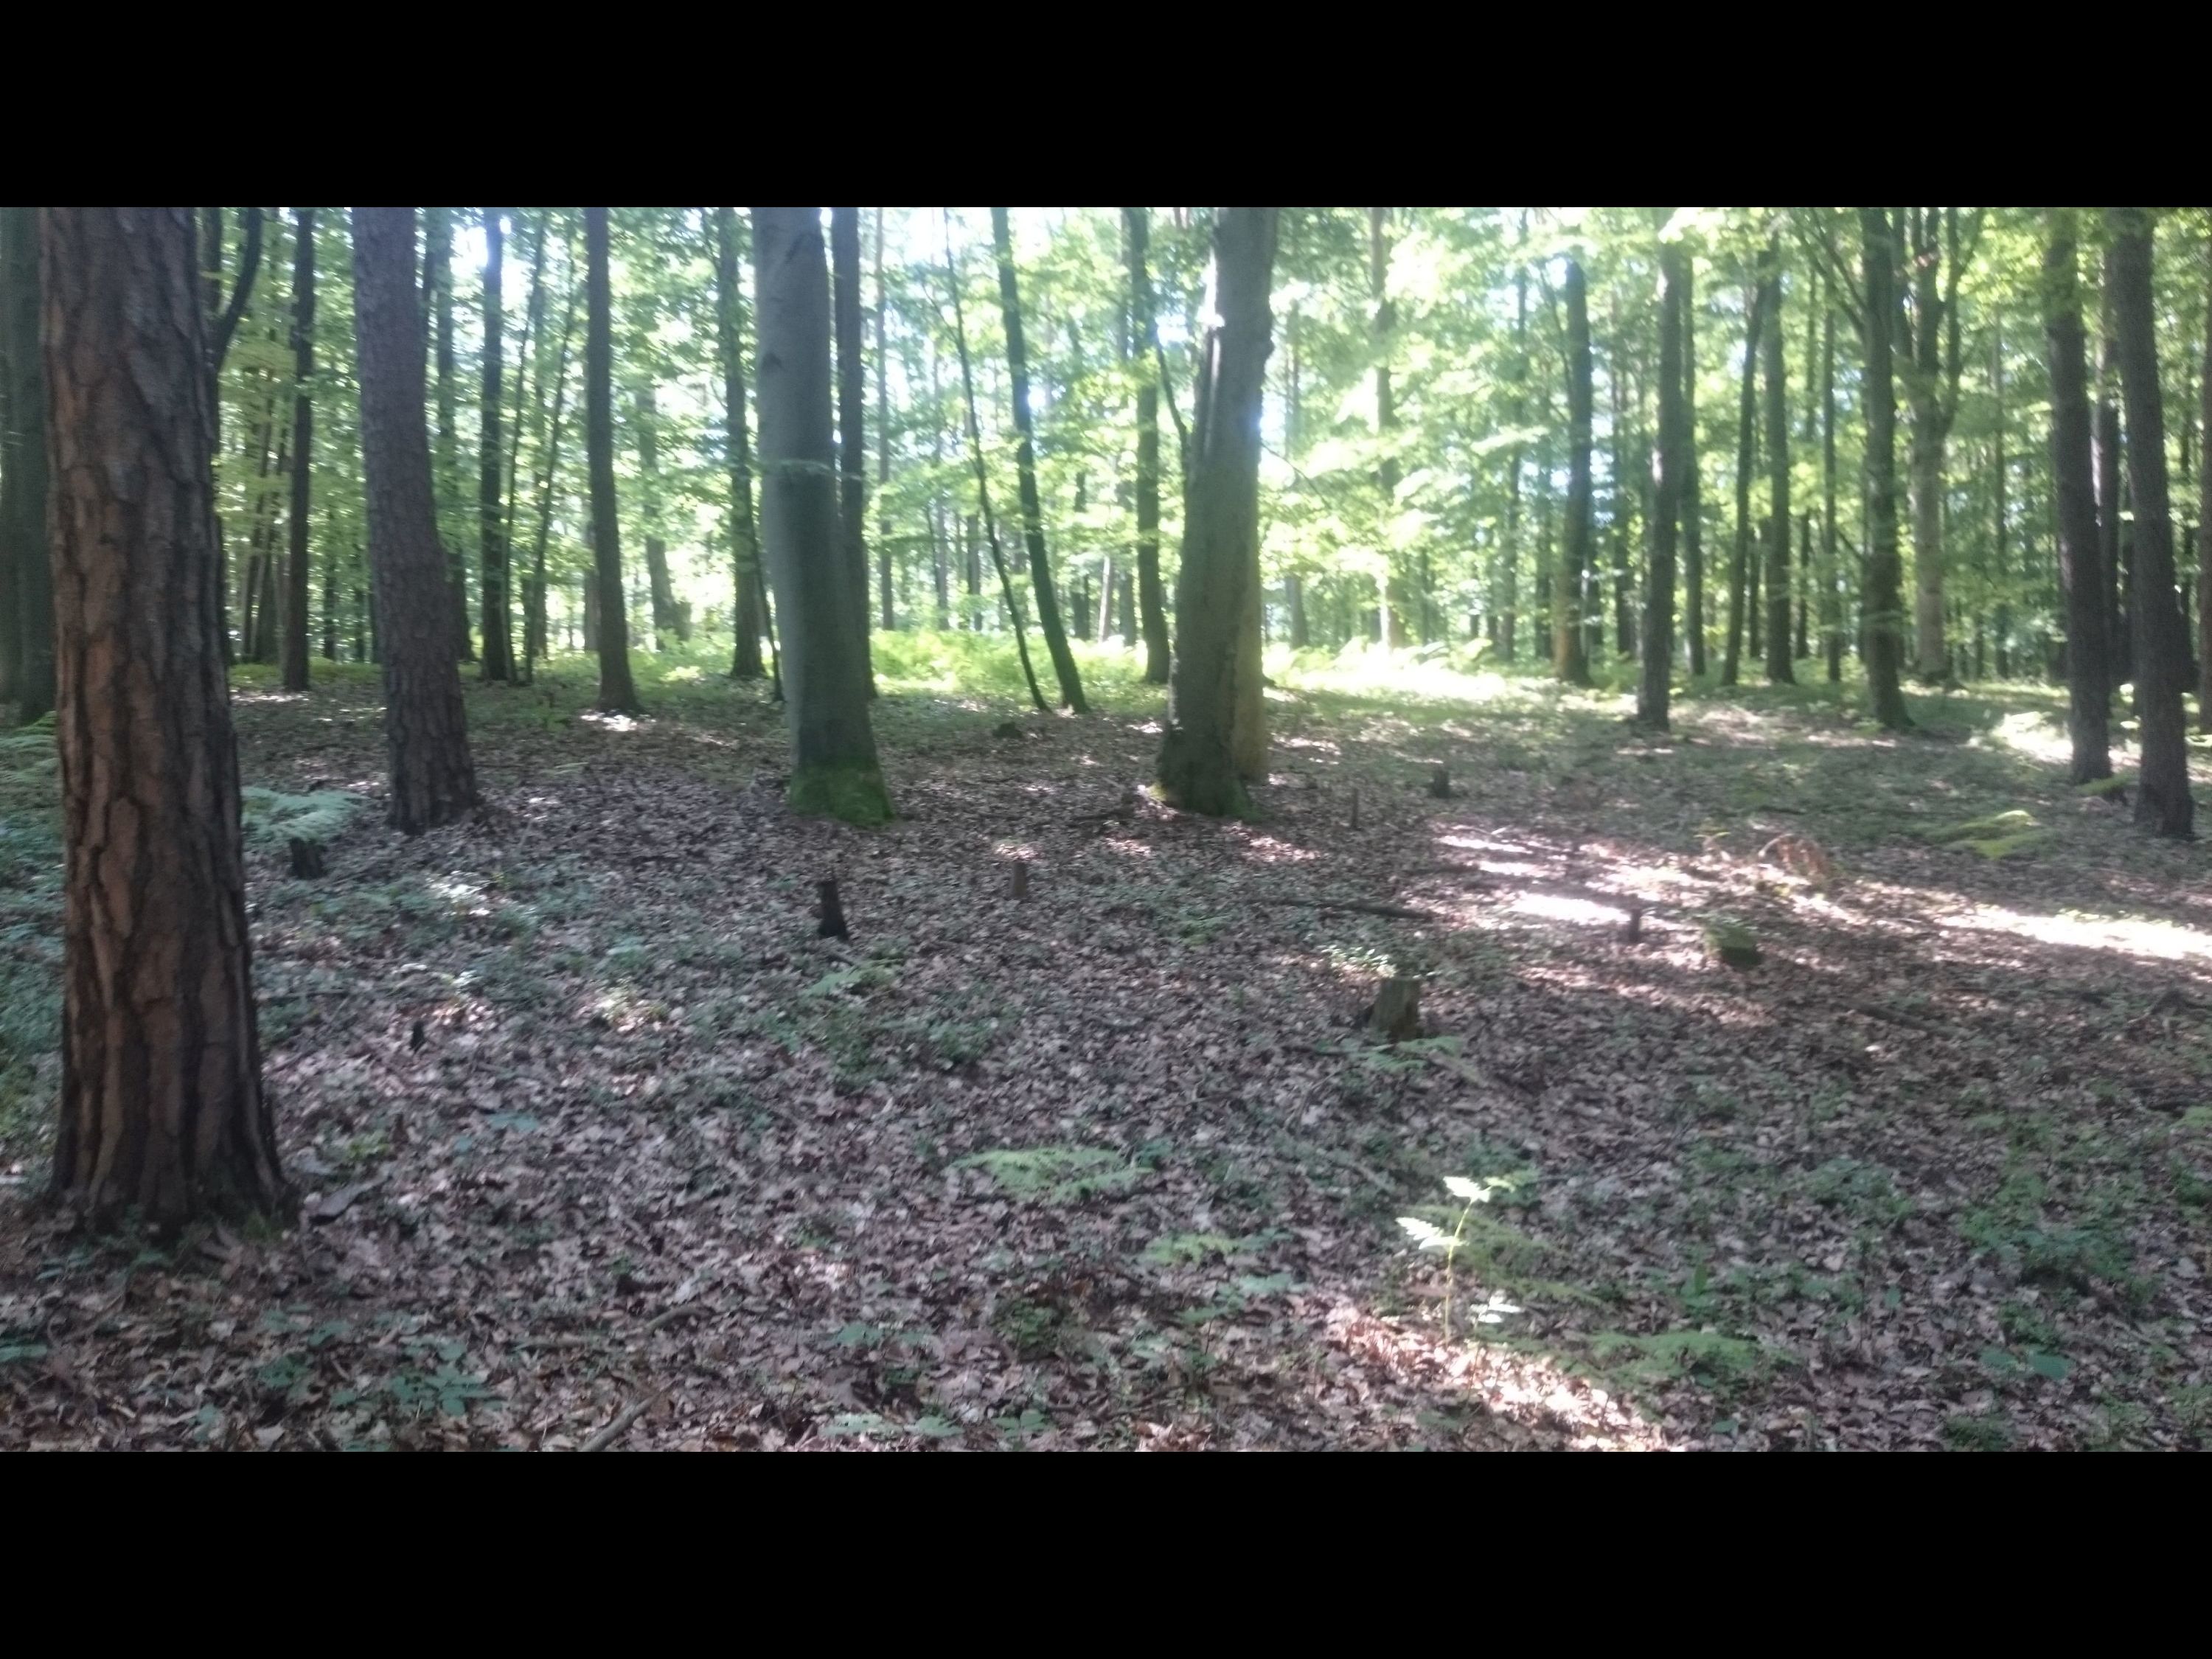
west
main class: Woodland
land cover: Pine dominated mixed woodland
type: hemiboreal forest and nemoral coniferous forest and mixed broadleaved-coniferous forest
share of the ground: > 75 %
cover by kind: coniferous forest trees 50 %, broadleaved forest trees 35 %, unconsolidated bare surface 10 %, herbaceous plants 5 %
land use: Forestry
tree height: > 5 m
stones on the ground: < 10 %
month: July
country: AT
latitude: 47.0155
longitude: 15.9601
